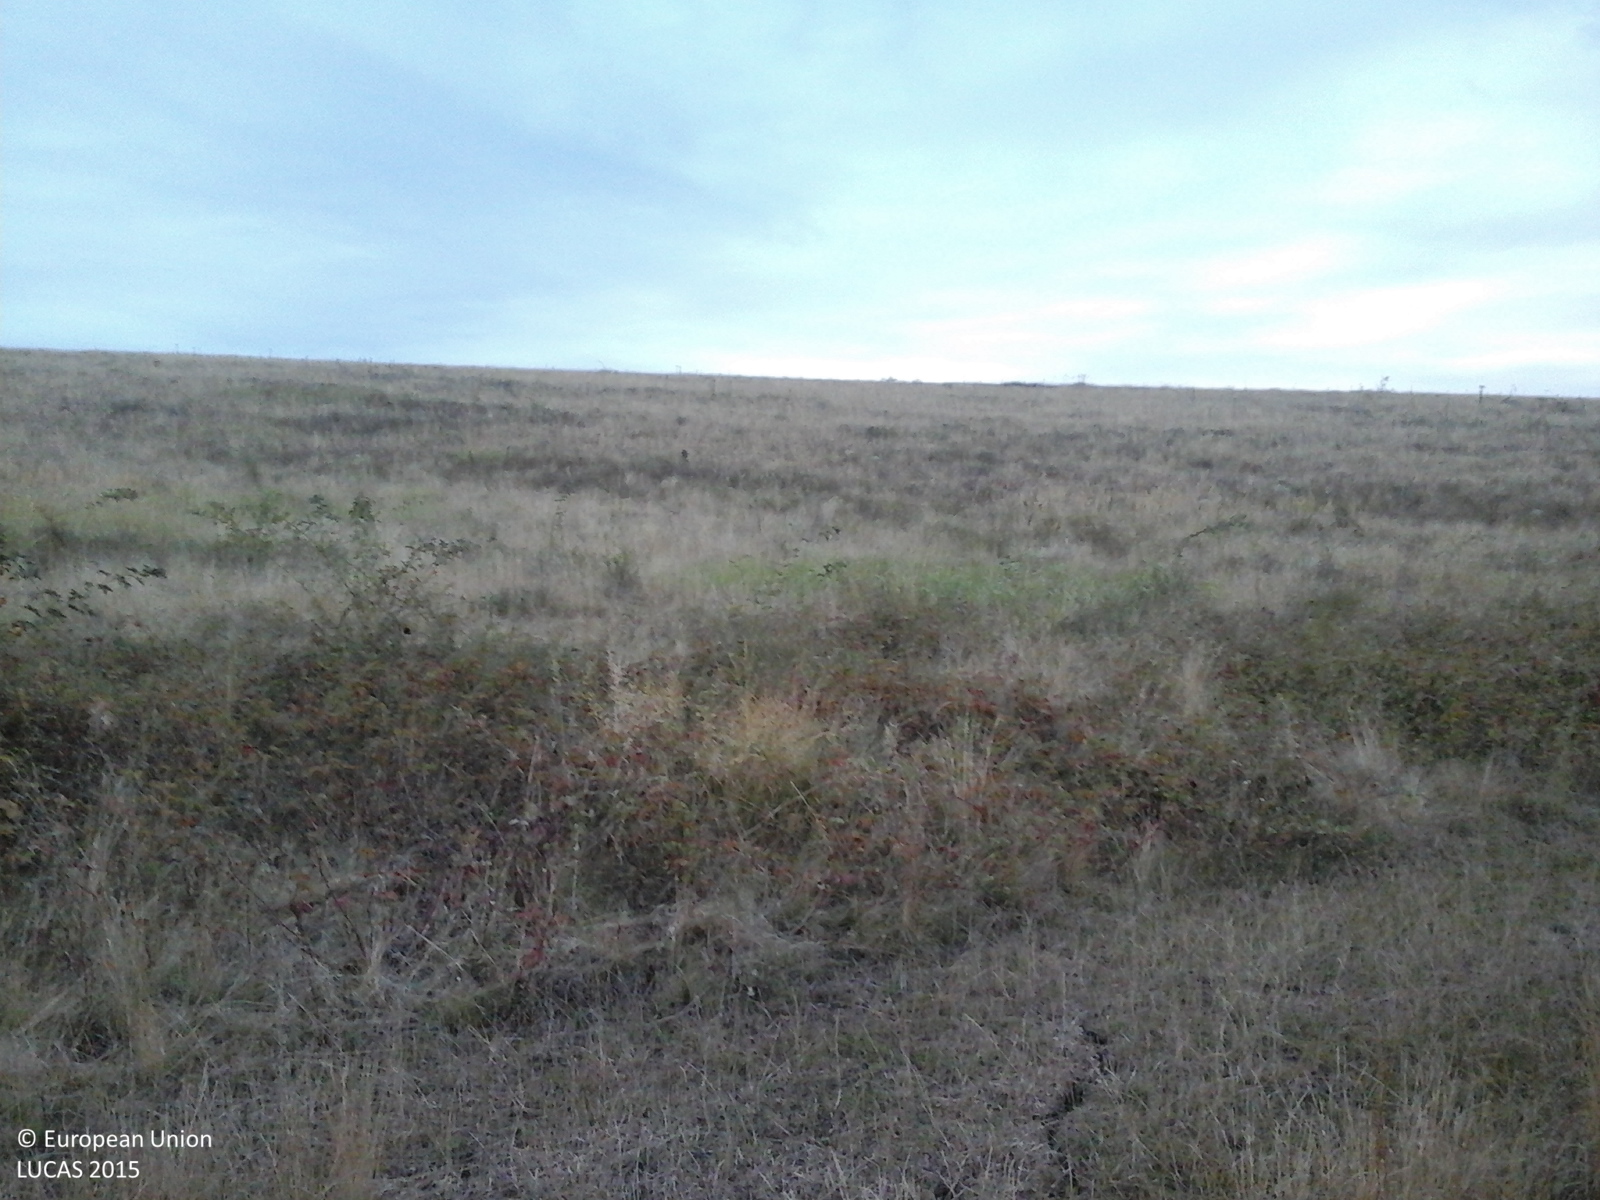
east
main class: Grassland
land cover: Grassland with sparse tree/shrub cover
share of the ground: > 75 %
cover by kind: herbaceous plants 85 %, shrubs 10 %, broadleaved forest trees 5 %
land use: Agriculture (excluding fallow land and kitchen gardens)
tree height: < 5 m
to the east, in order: Grassland with sparse tree/shrub cover; Tracks; Grassland with sparse tree/shrub cover; Tracks; Grassland without tree/shrub cover
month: August
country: RO
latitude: 45.8317
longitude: 21.5566
